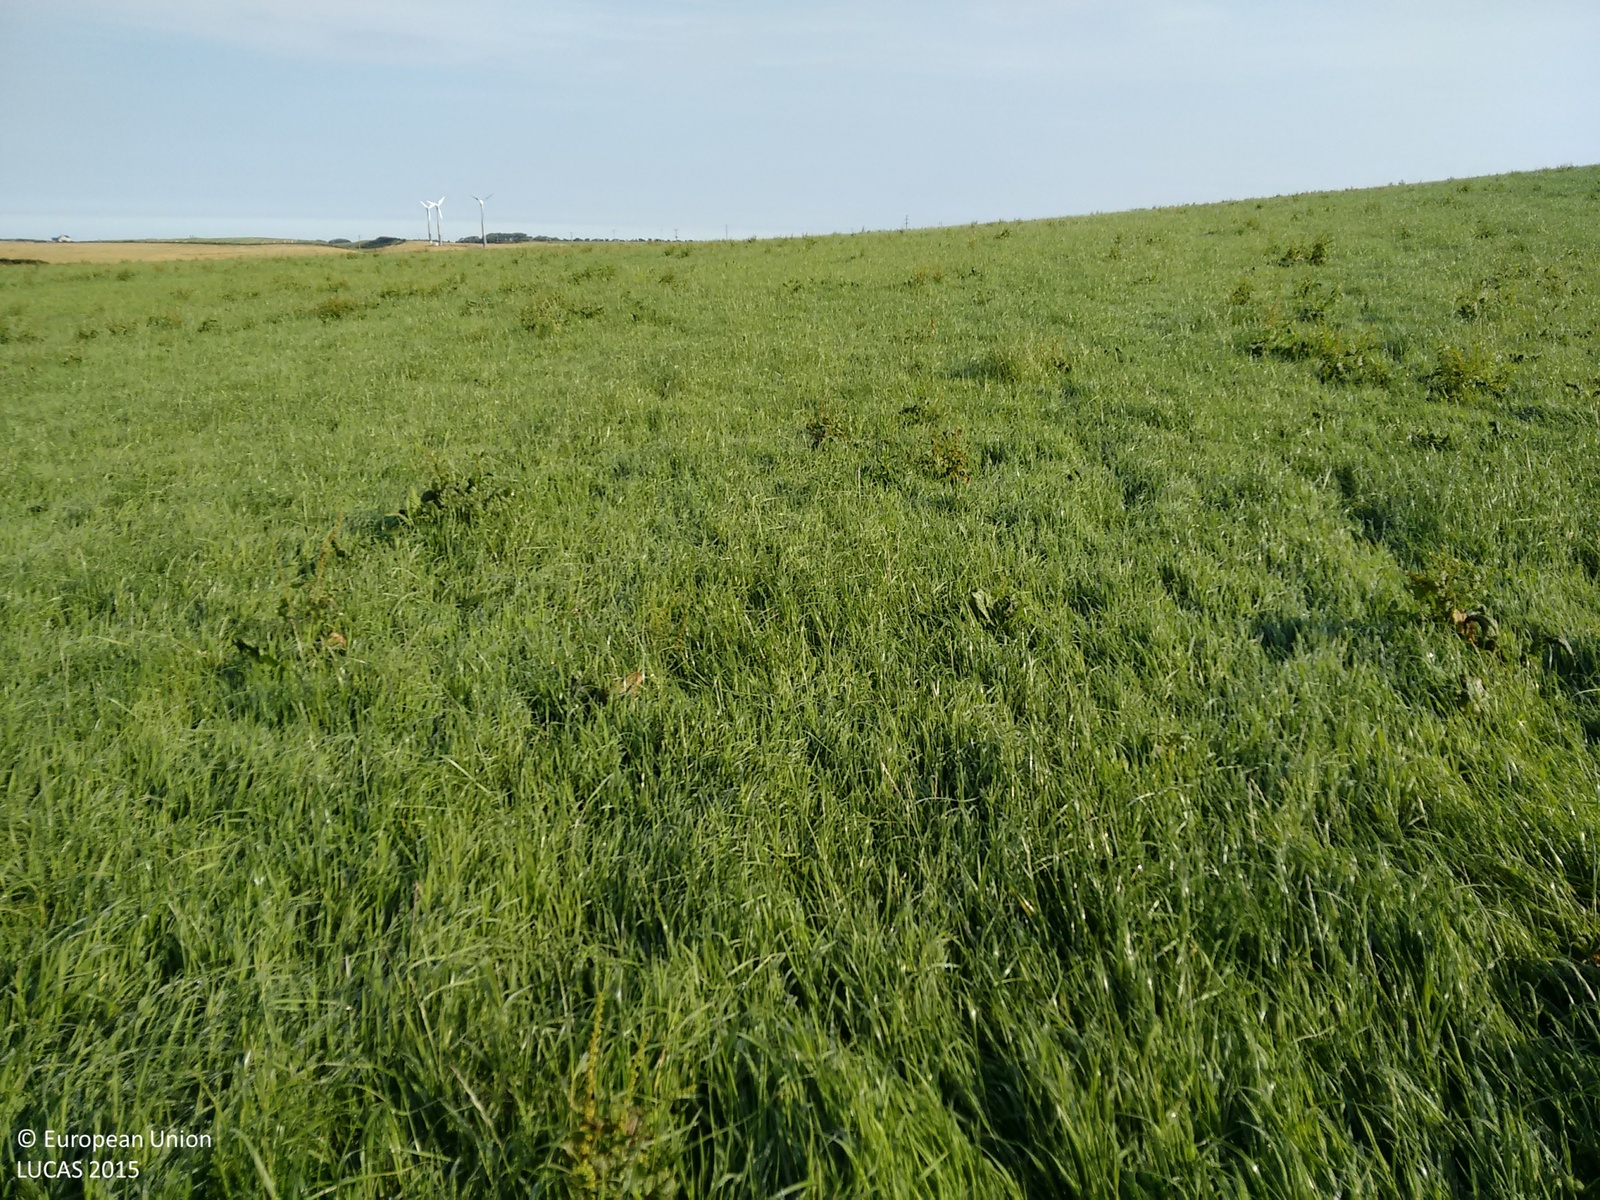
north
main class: Grassland
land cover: Grassland without tree/shrub cover
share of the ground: > 75 %
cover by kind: herbaceous plants 100 %
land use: Agriculture (excluding fallow land and kitchen gardens)
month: August
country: GB
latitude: 54.9052
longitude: -5.0723
